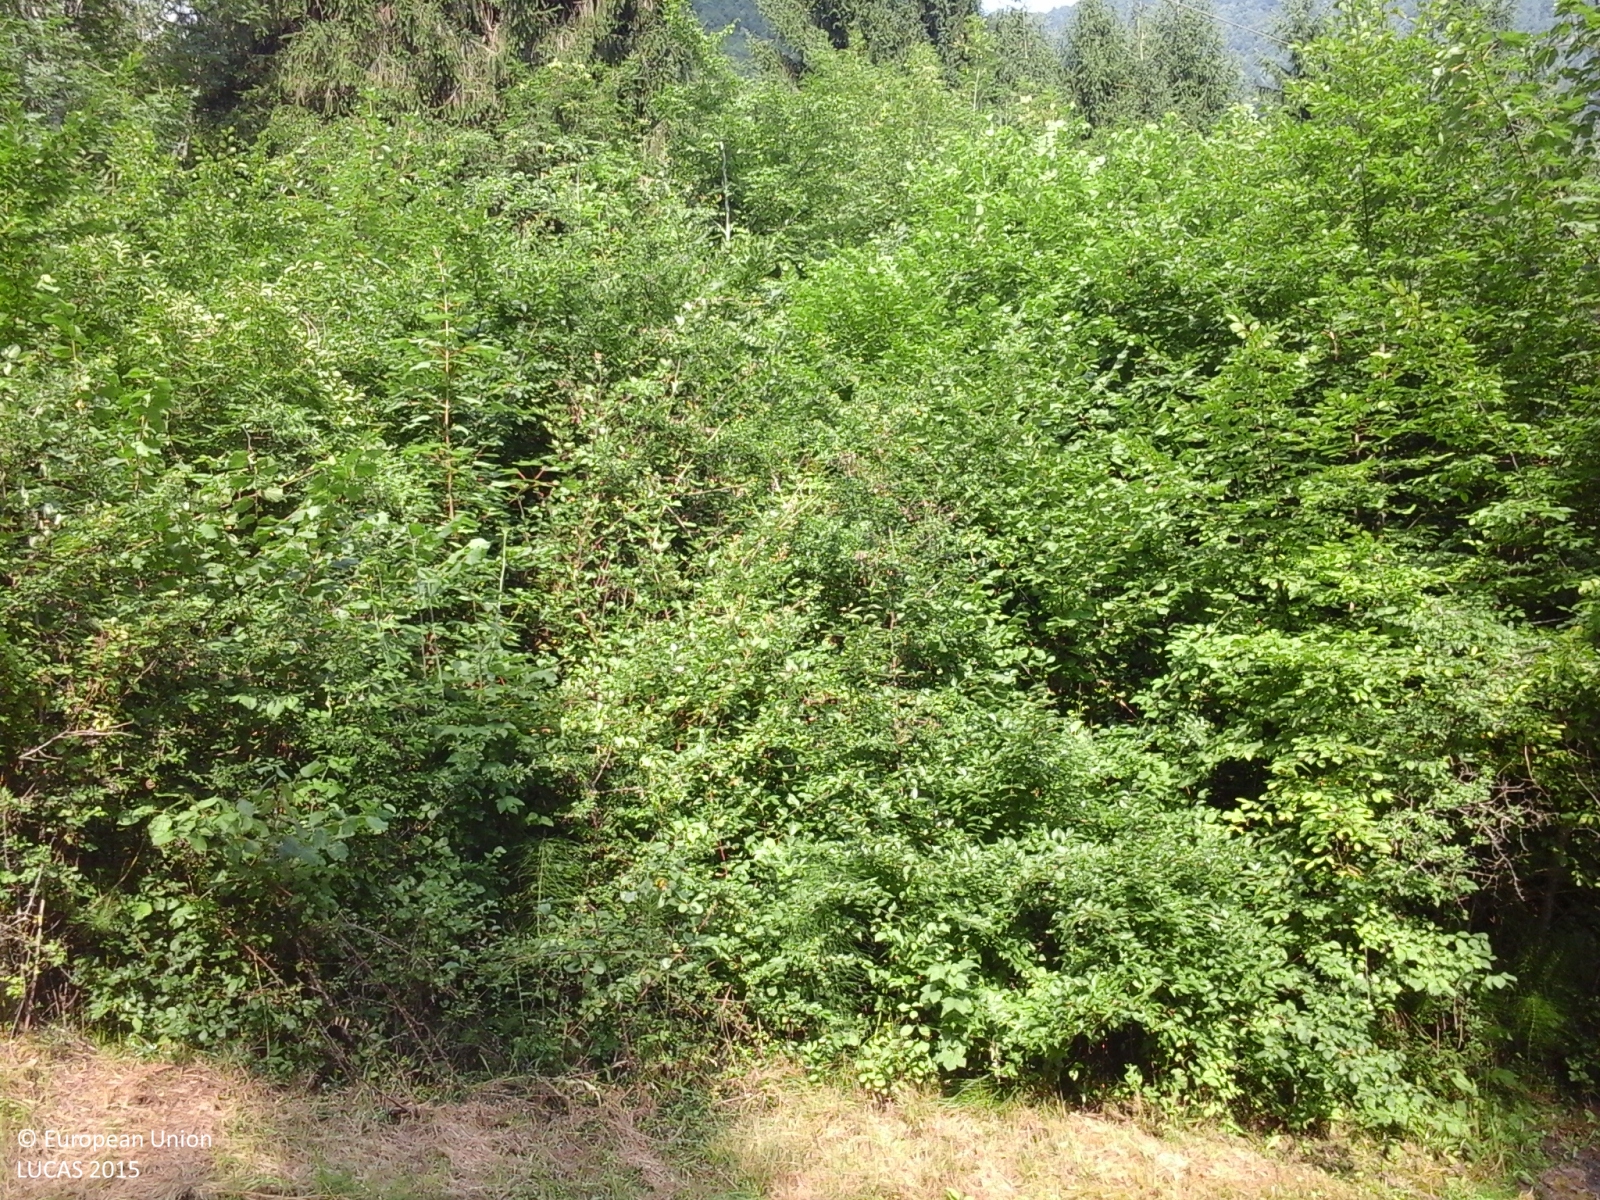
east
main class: Woodland
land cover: Broadleaved woodland
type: thermophilous deciduous forest
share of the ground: > 75 %
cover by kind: broadleaved forest trees 100 %
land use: Semi-natural and natural areas not in use
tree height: > 5 m
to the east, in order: Broadleaved woodland; Electric lines; Broadleaved woodland; Other mixed woodland
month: July
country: IT
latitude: 46.0992
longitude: 11.9507
